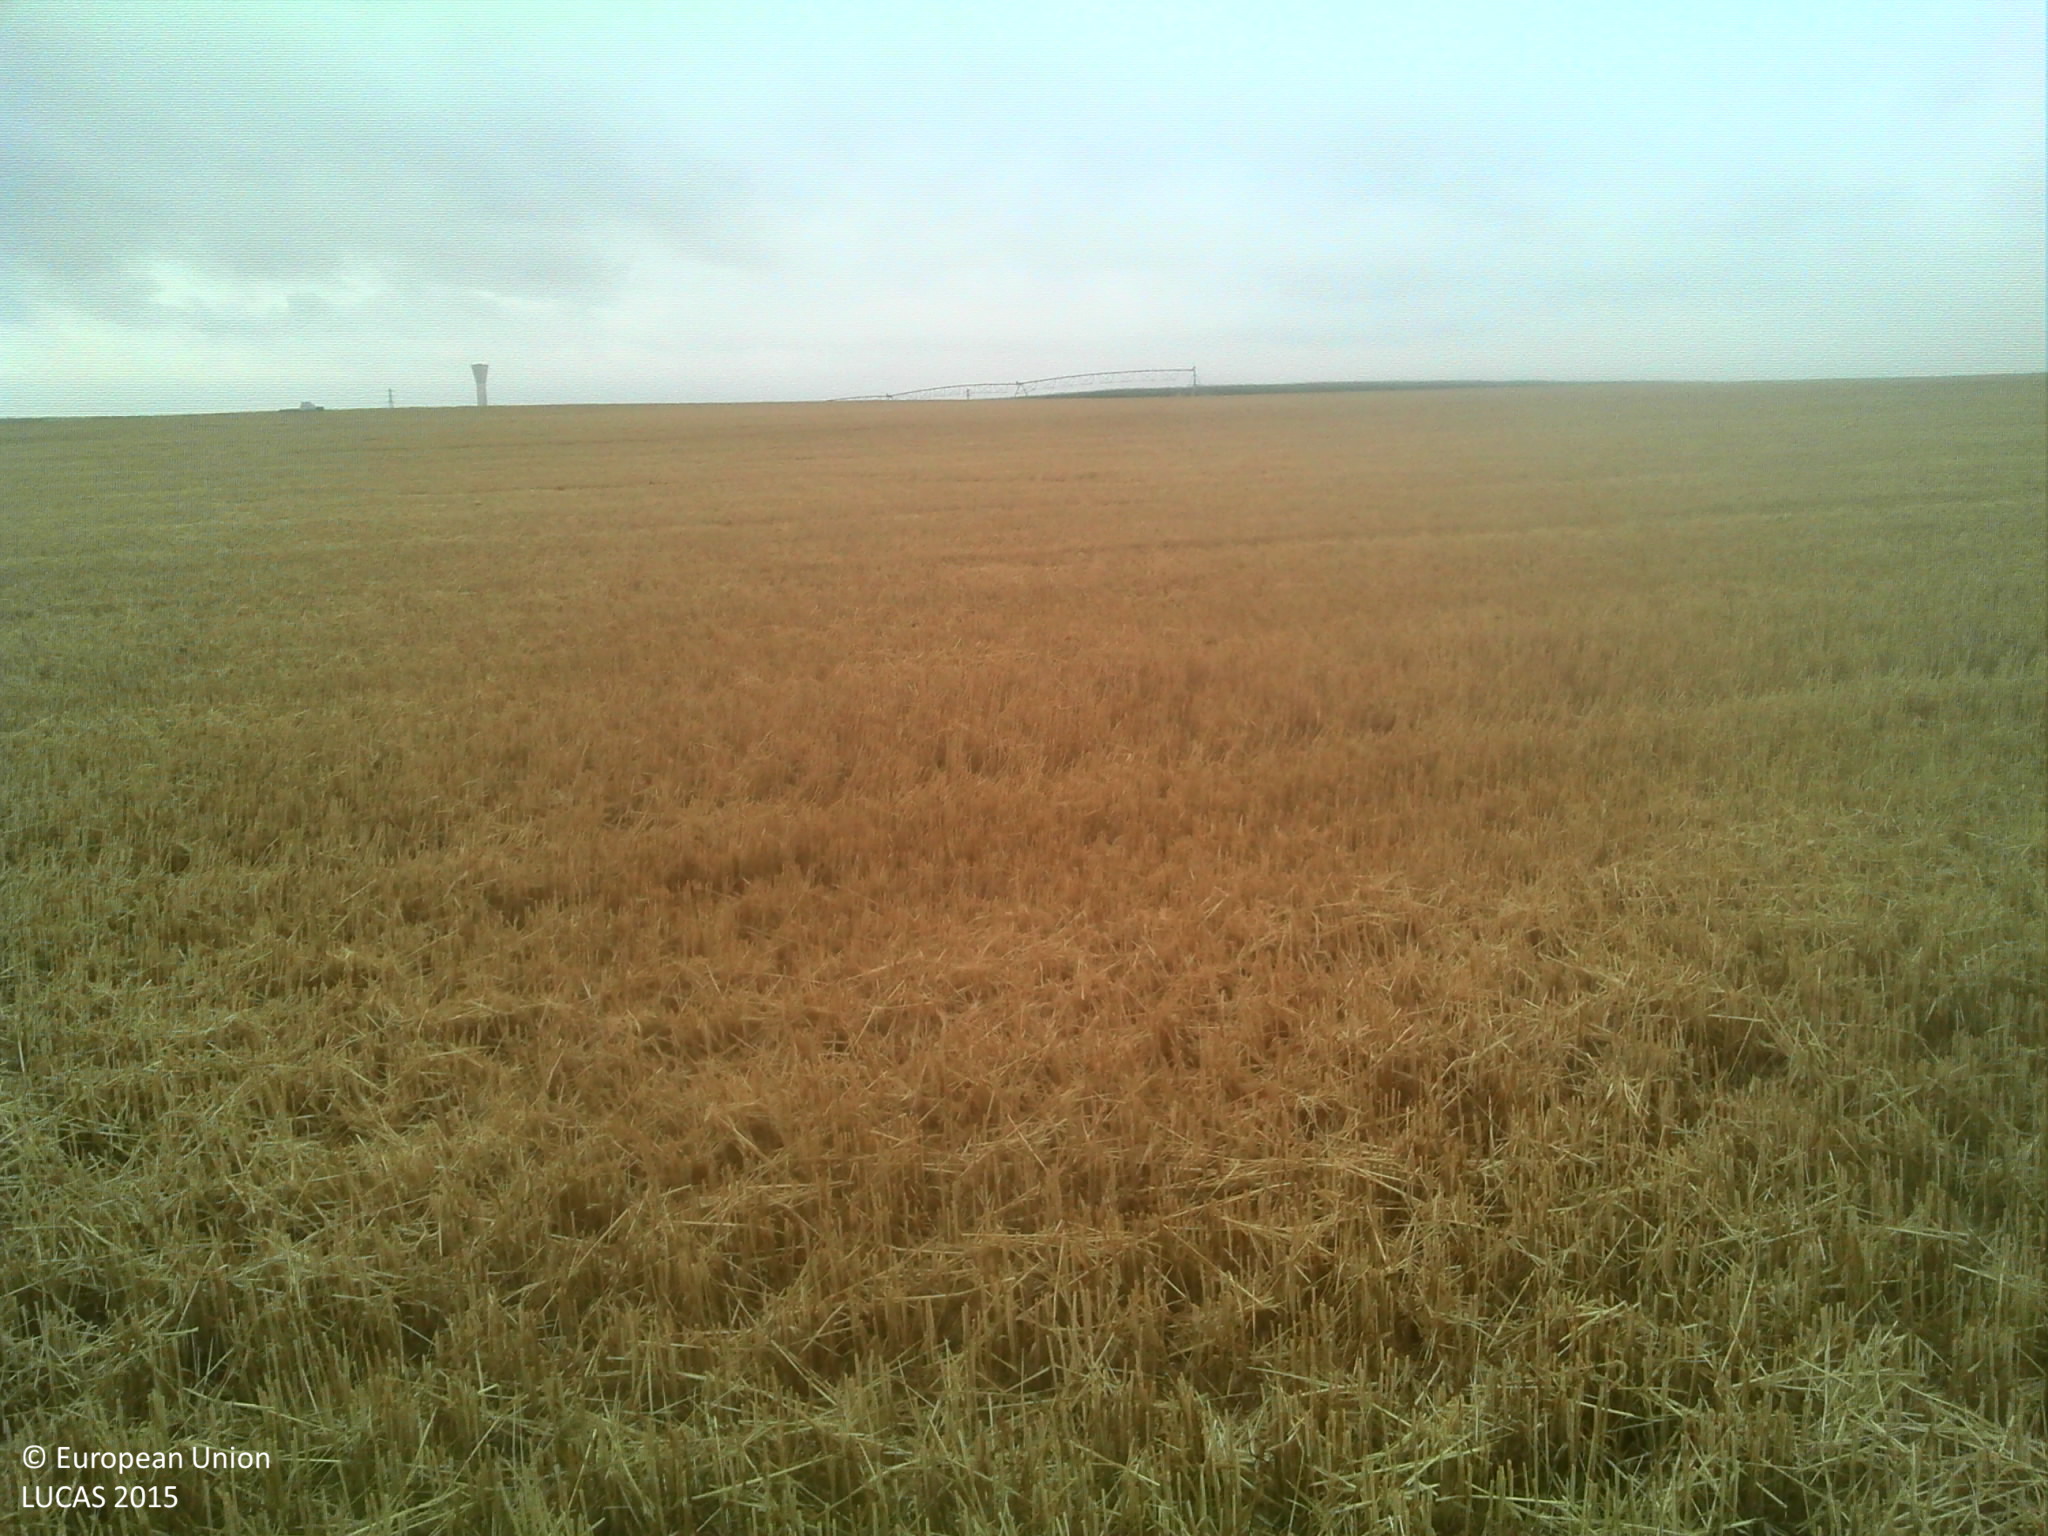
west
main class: Cropland
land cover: Durum wheat
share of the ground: > 75 %
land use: Agriculture (excluding fallow land and kitchen gardens)
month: July
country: FR
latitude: 47.6831
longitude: 1.3388
